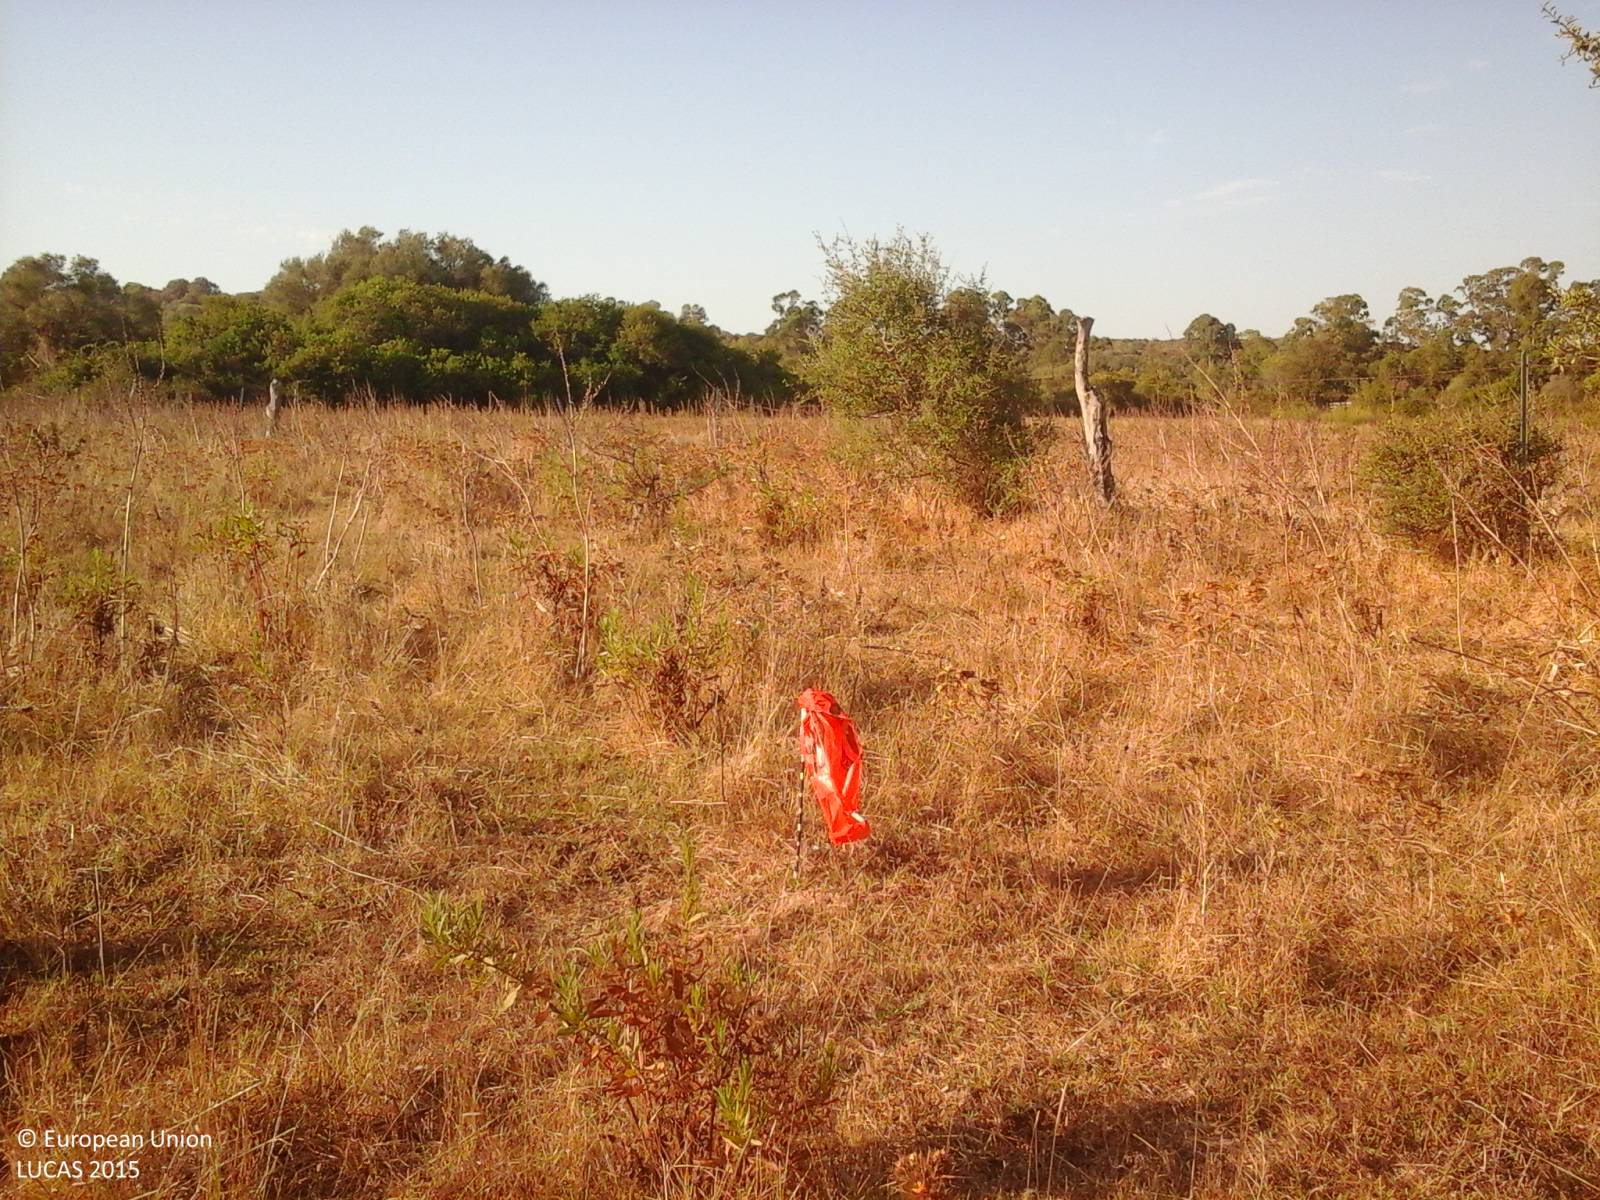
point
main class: Grassland
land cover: Grassland without tree/shrub cover
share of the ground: > 75 %
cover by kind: herbaceous plants 95 %, shrubs 5 %
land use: Agriculture (excluding fallow land and kitchen gardens)
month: September
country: IT
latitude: 41.0618
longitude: 9.4196
